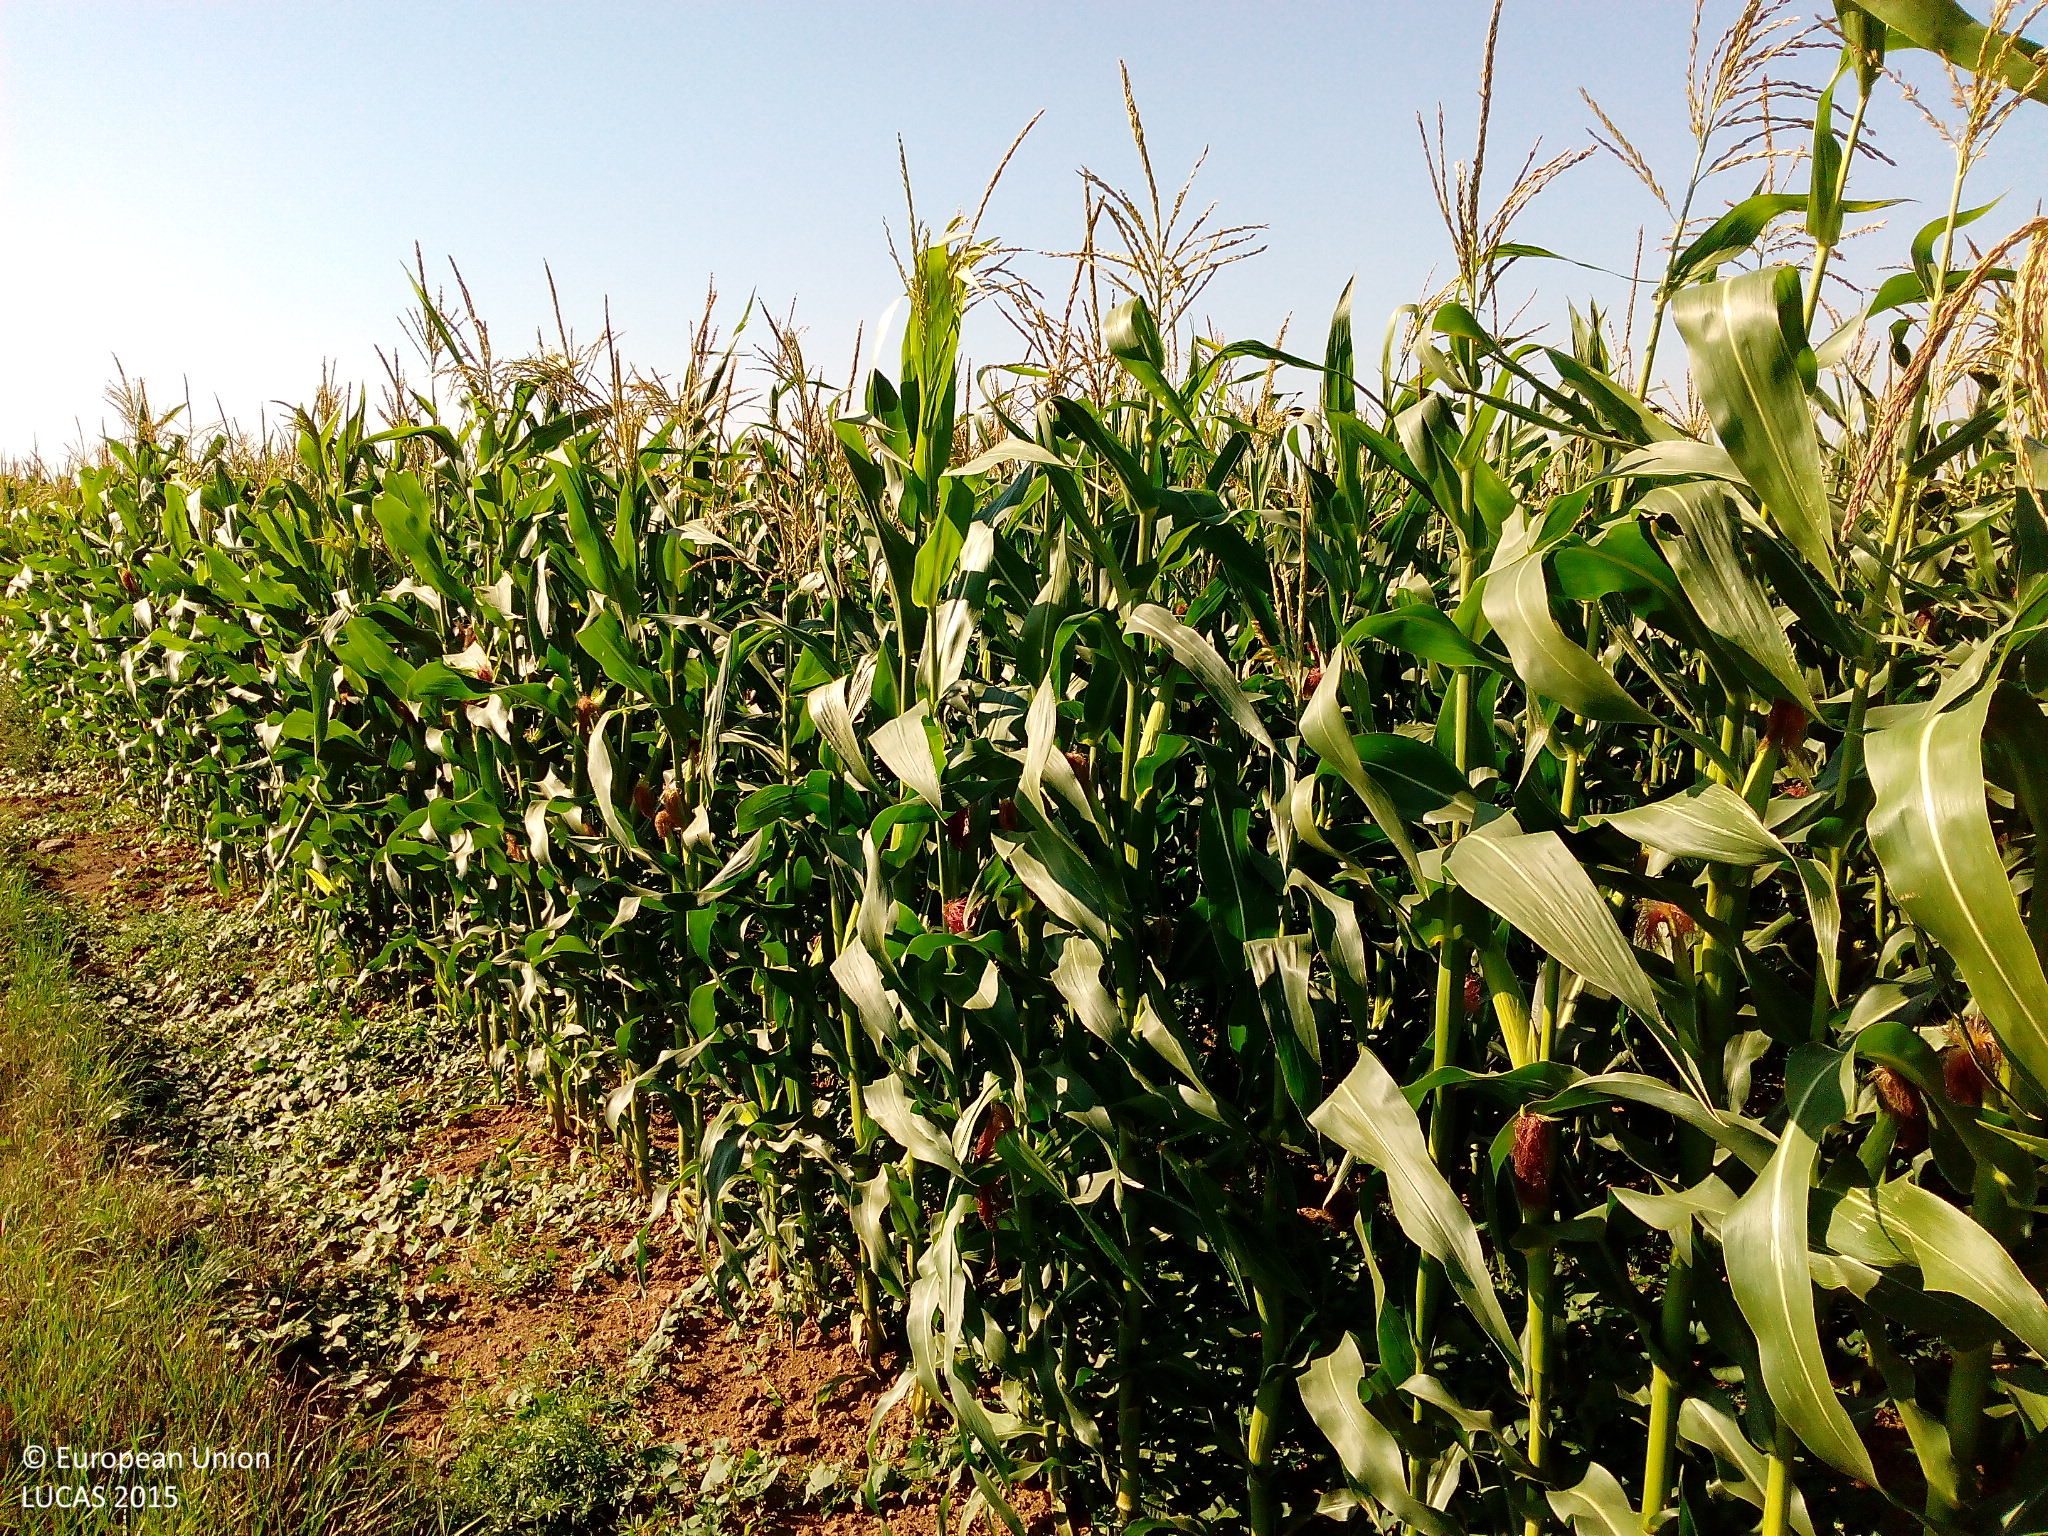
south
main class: Cropland
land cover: Maize
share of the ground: > 75 %
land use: Agriculture (excluding fallow land and kitchen gardens)
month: August
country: DE
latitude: 50.6858
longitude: 9.3350
